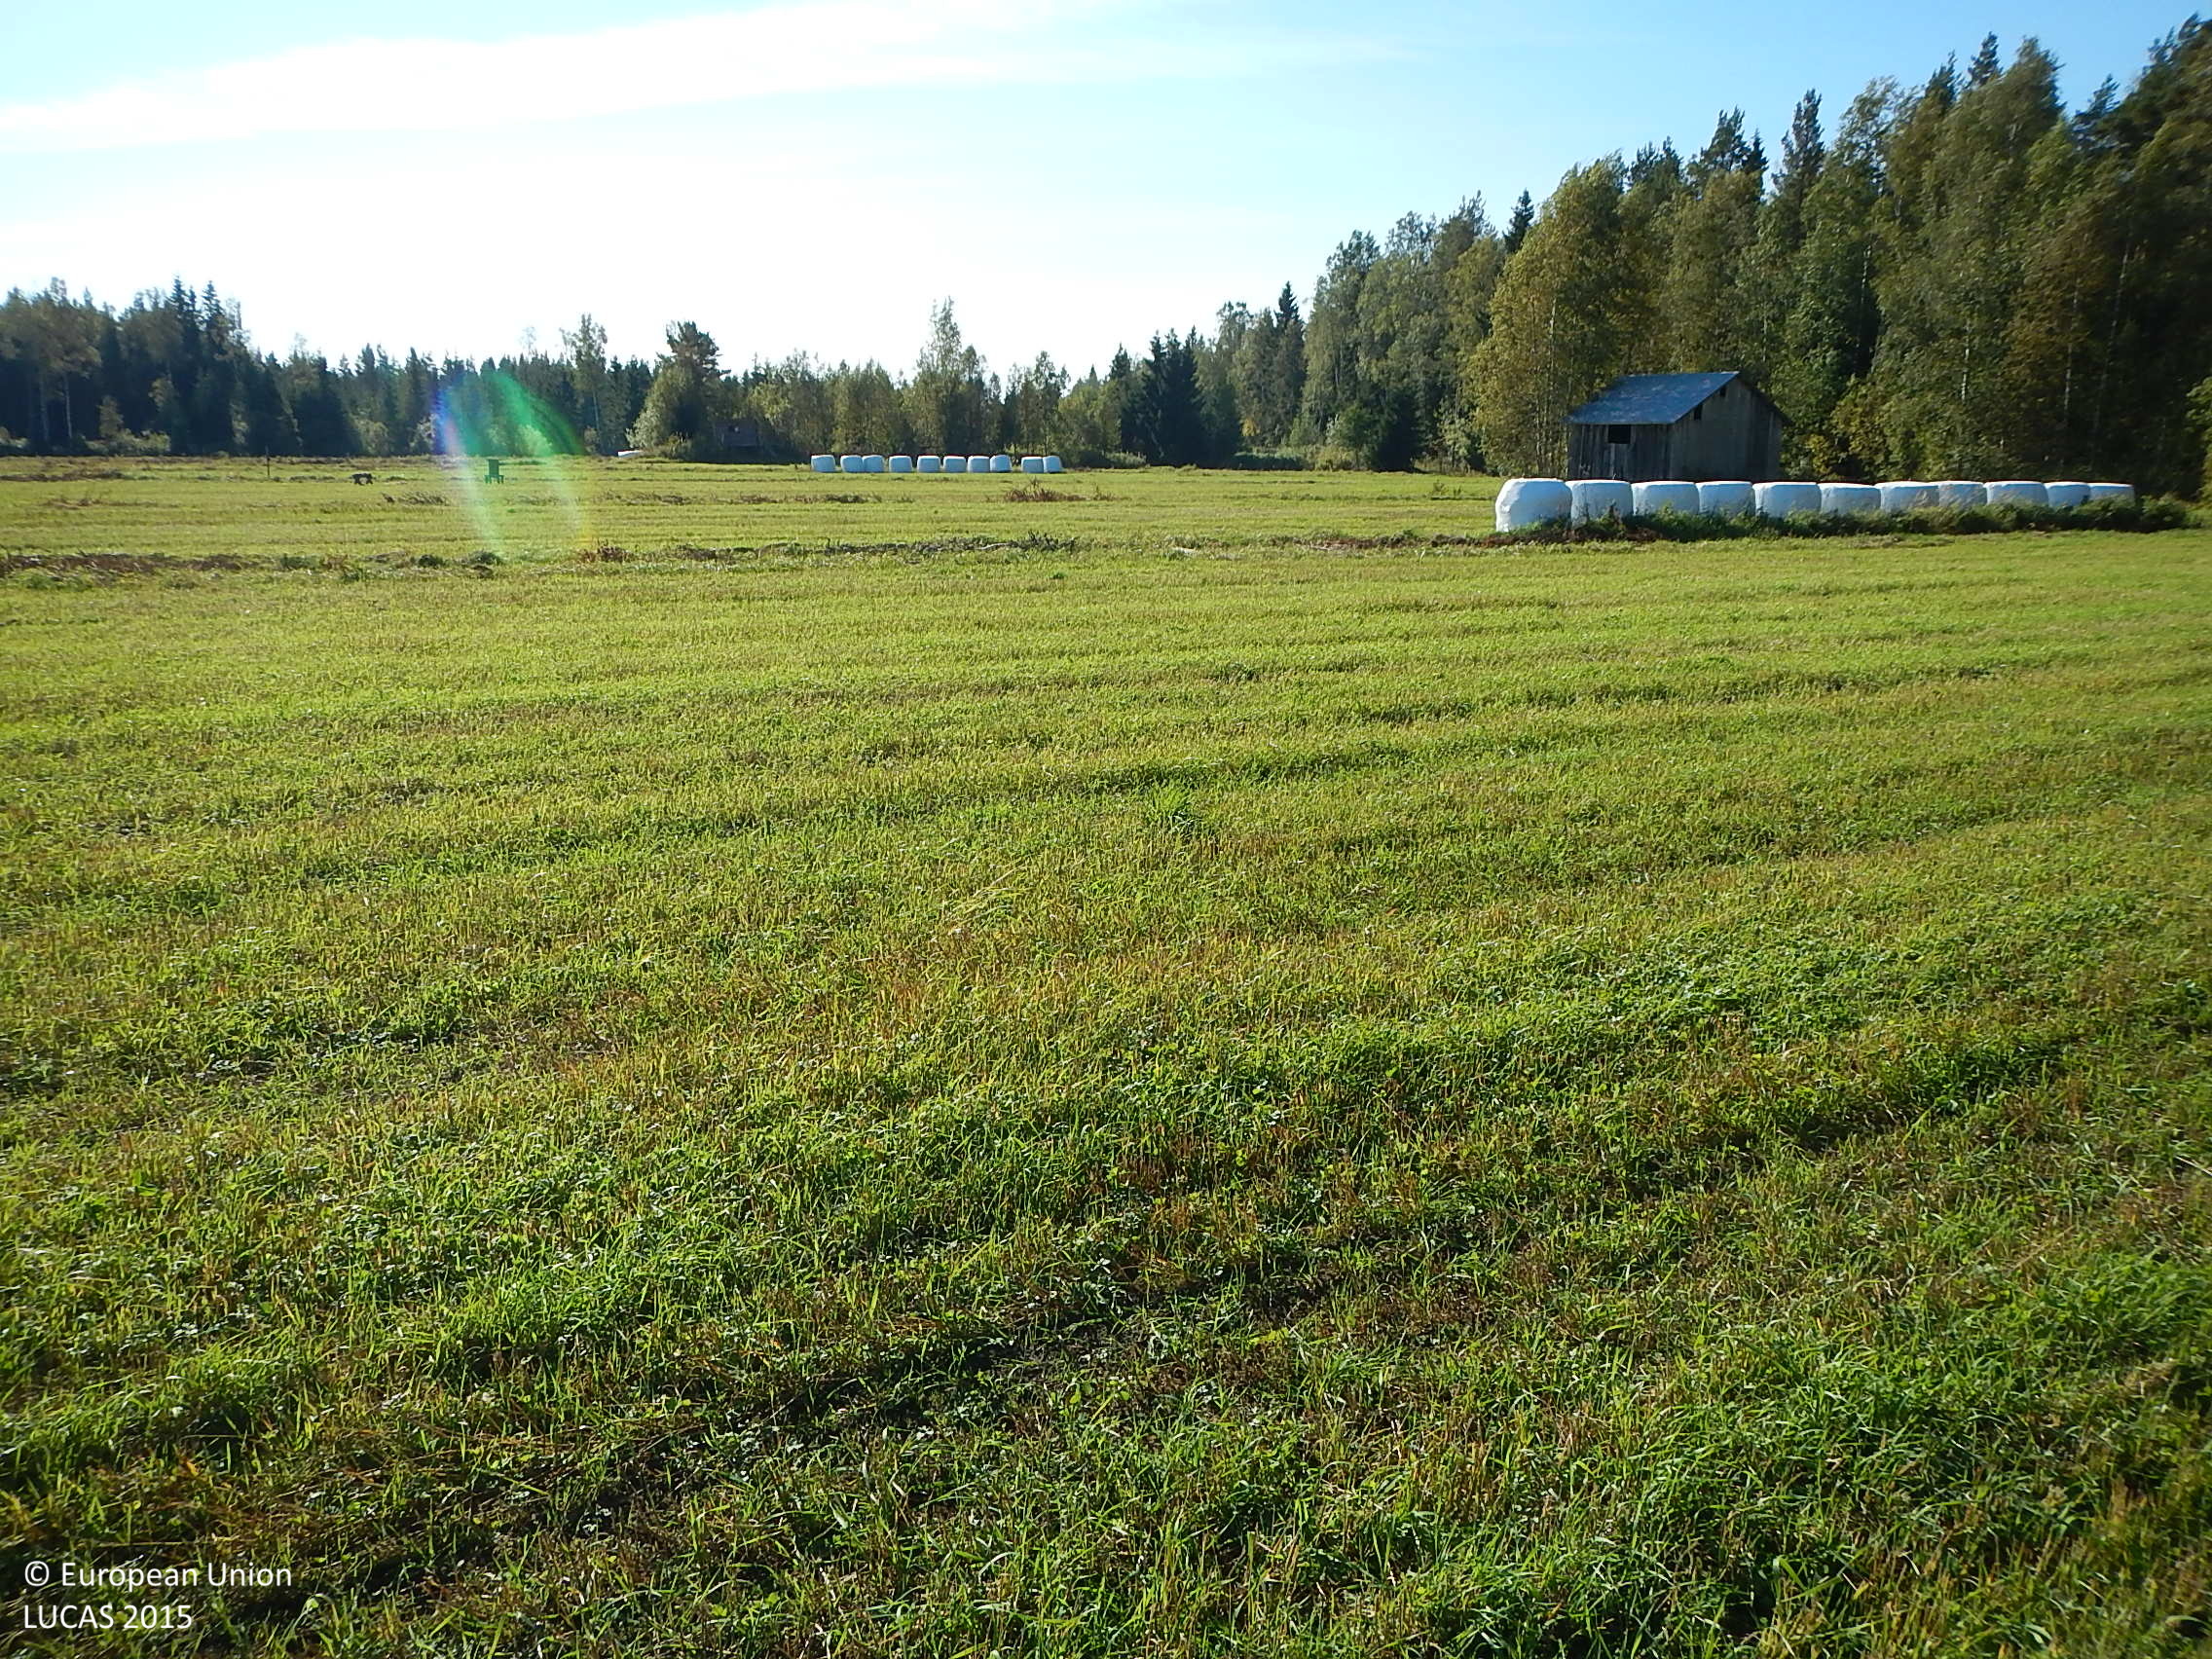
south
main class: Cropland
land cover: Oats
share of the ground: > 75 %
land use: Agriculture (excluding fallow land and kitchen gardens)
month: September
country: FI
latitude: 61.9864
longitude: 21.5175
